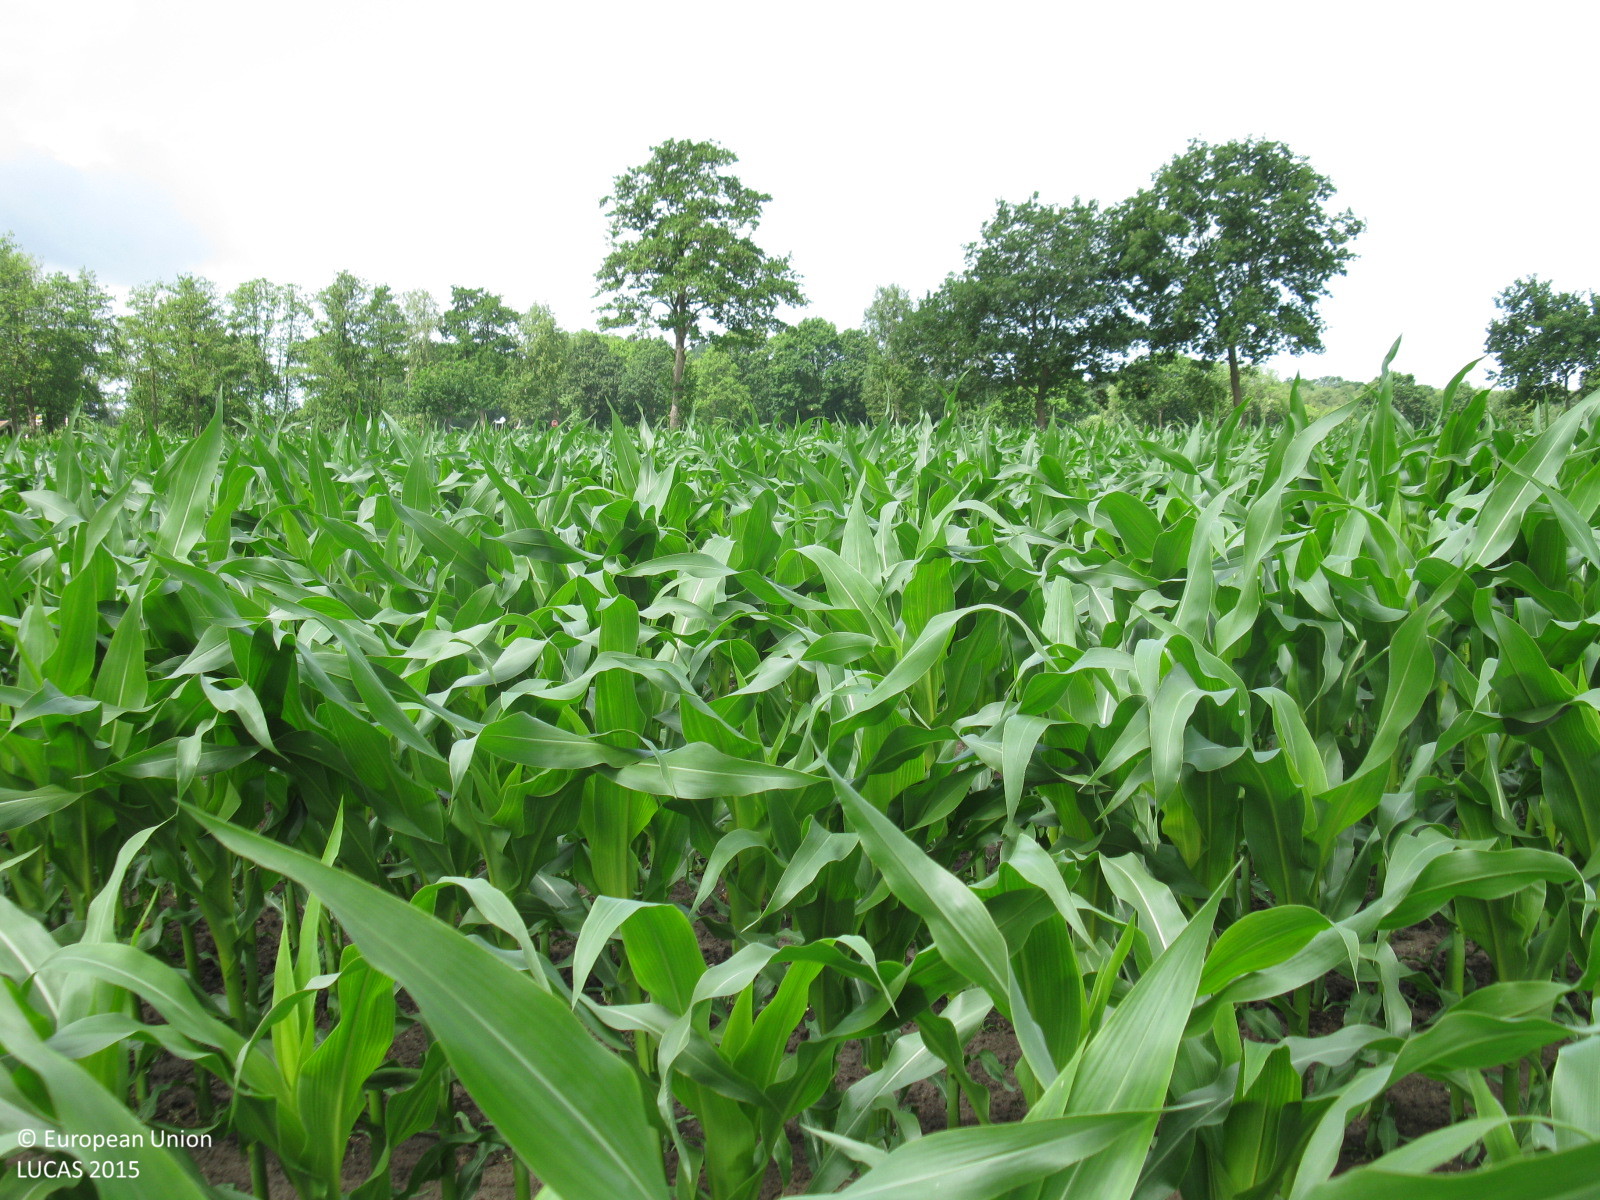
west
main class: Cropland
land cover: Maize
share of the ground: > 75 %
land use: Agriculture (excluding fallow land and kitchen gardens)
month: July
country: DE
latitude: 53.4558
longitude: 7.9074
